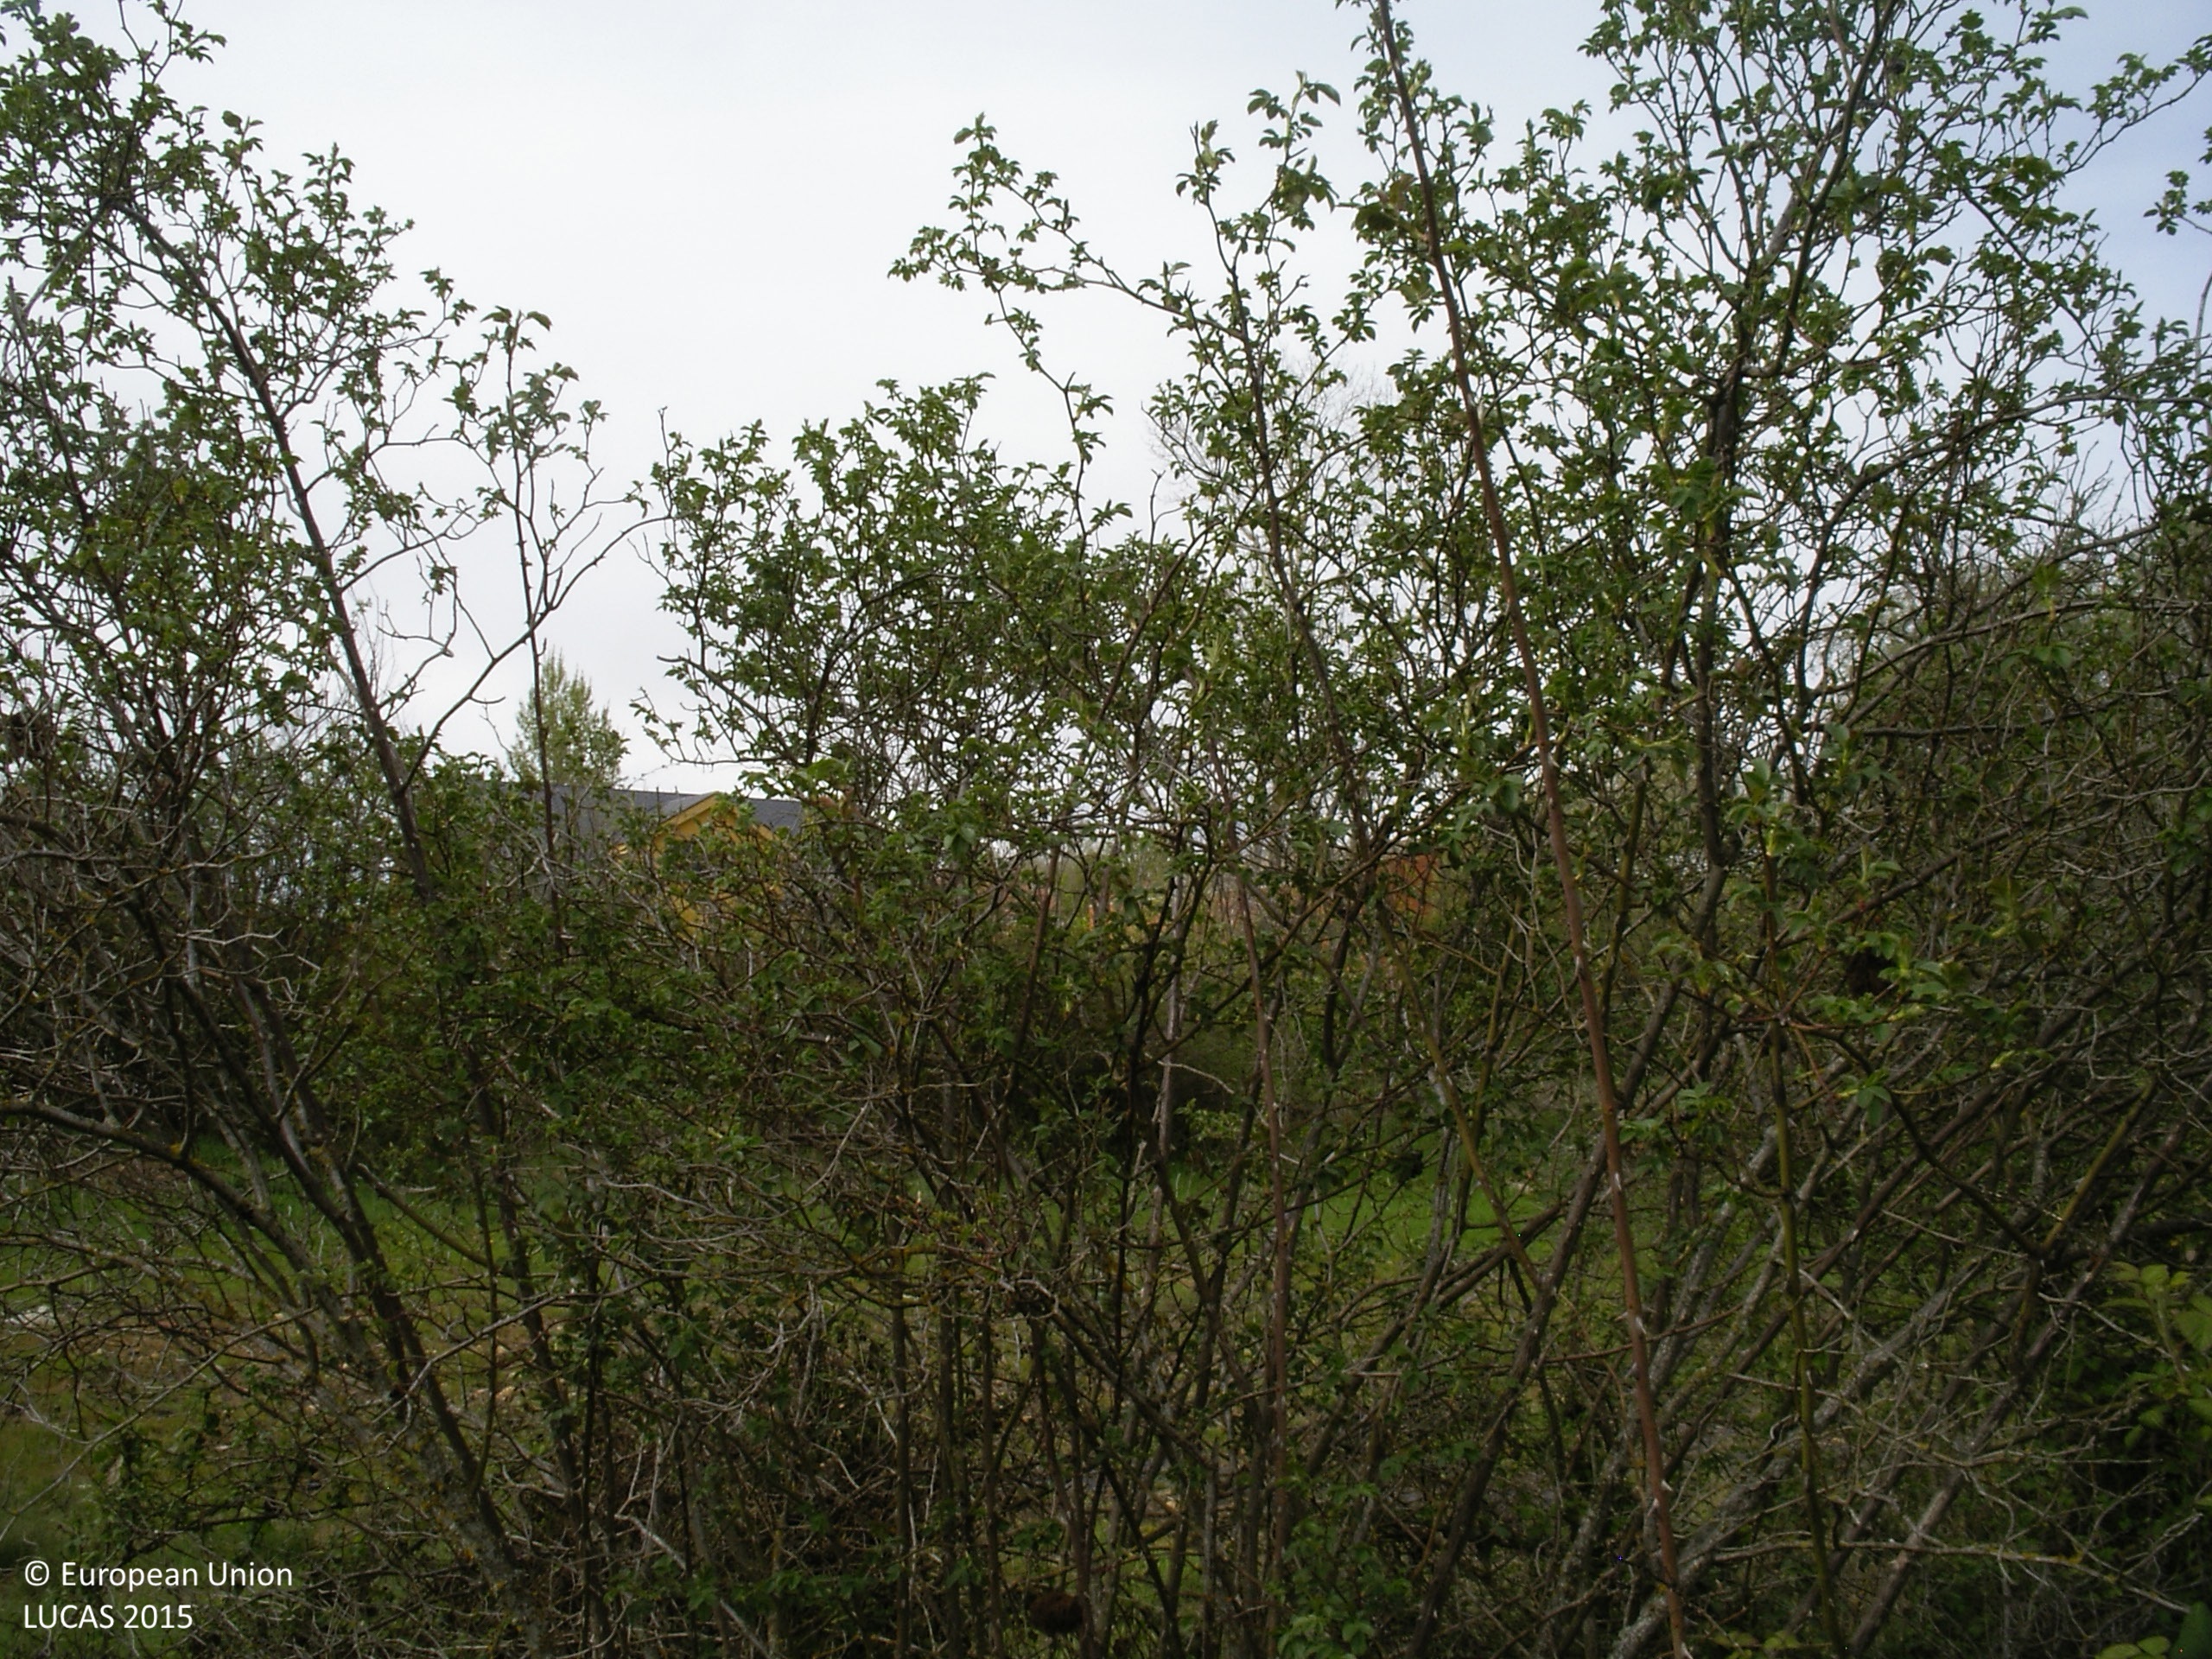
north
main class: Grassland
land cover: Grassland with sparse tree/shrub cover
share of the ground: > 75 %
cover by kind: herbaceous plants 90 %, broadleaved forest trees 5 %, shrubs 5 %
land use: Abandoned areas
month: April
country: ES
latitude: 42.4809
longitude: -5.7309
